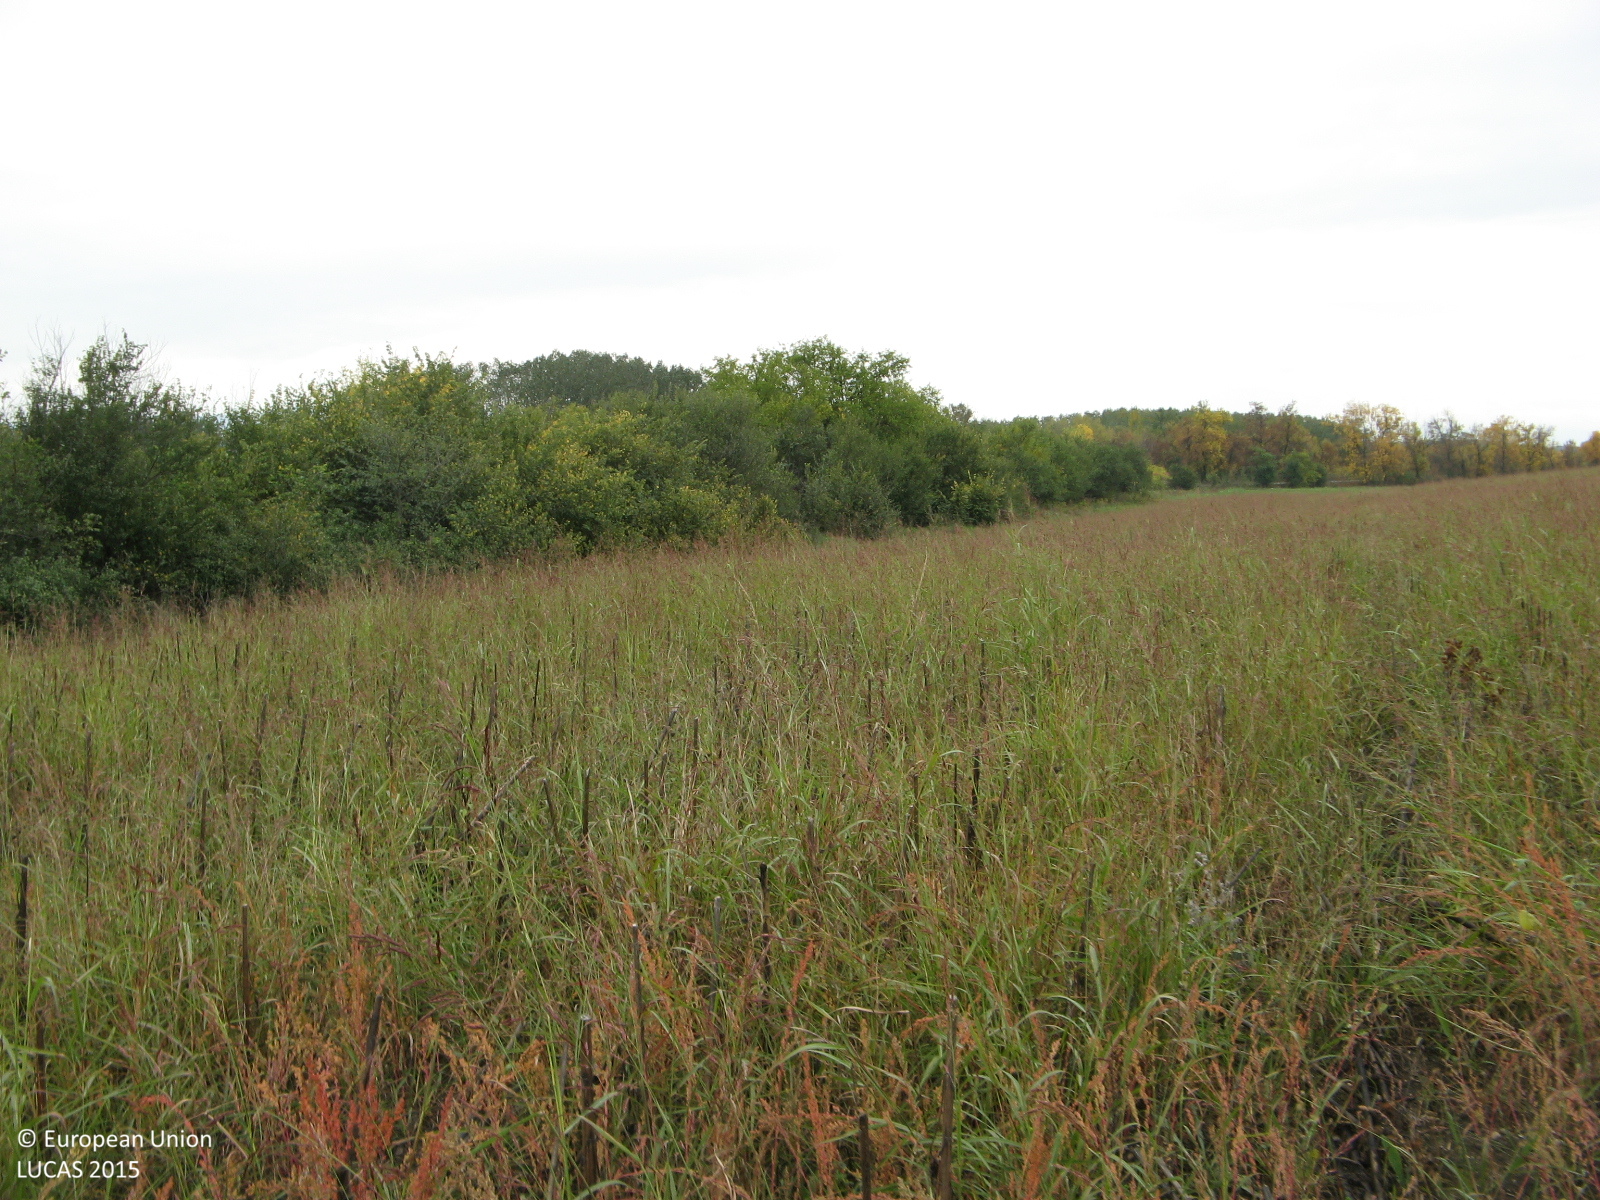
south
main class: Cropland
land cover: Sunflower
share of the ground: 10 - 25 %
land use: Agriculture (excluding fallow land and kitchen gardens)
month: October
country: BG
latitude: 42.0711
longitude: 25.1784
